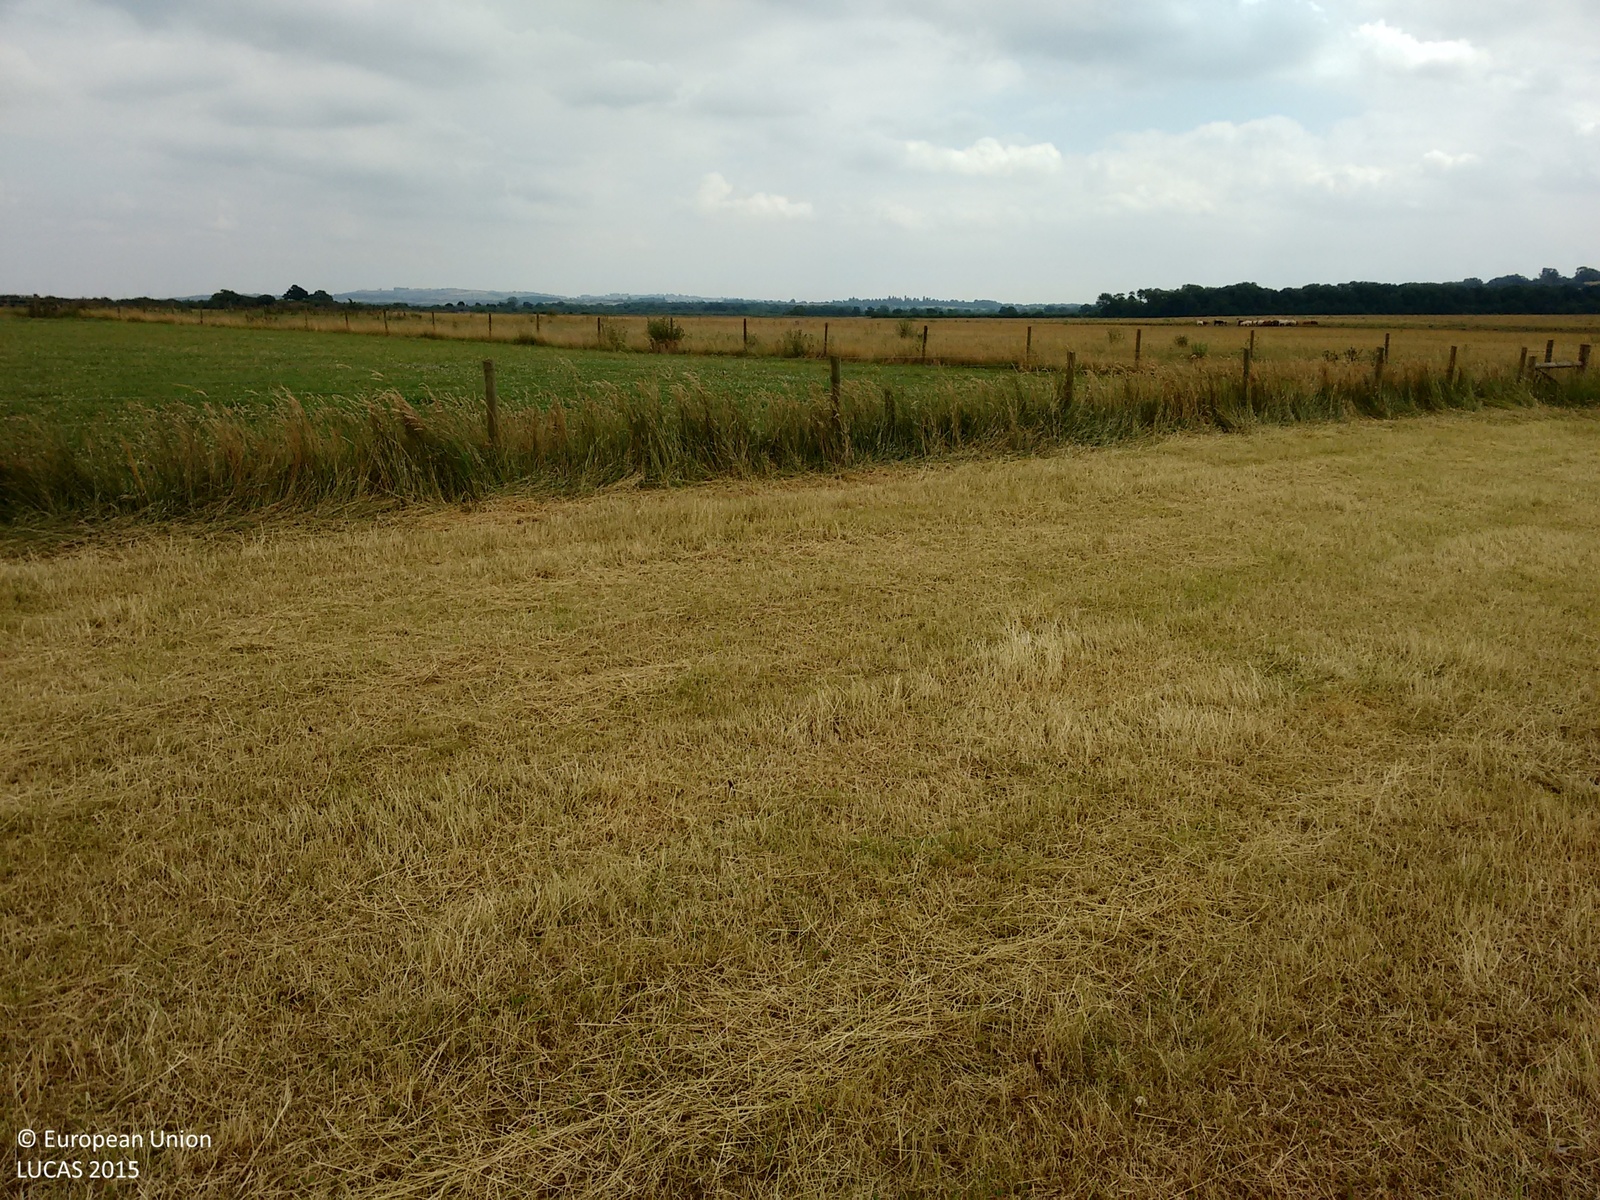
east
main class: Grassland
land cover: Grassland without tree/shrub cover
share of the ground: > 75 %
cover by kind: herbaceous plants 100 %
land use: Agriculture (excluding fallow land and kitchen gardens)
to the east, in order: Grassland without tree/shrub cover; Fences; Grassland without tree/shrub cover; Fences; Grassland without tree/shrub cover
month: July
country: GB
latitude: 51.8092
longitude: -1.2007
